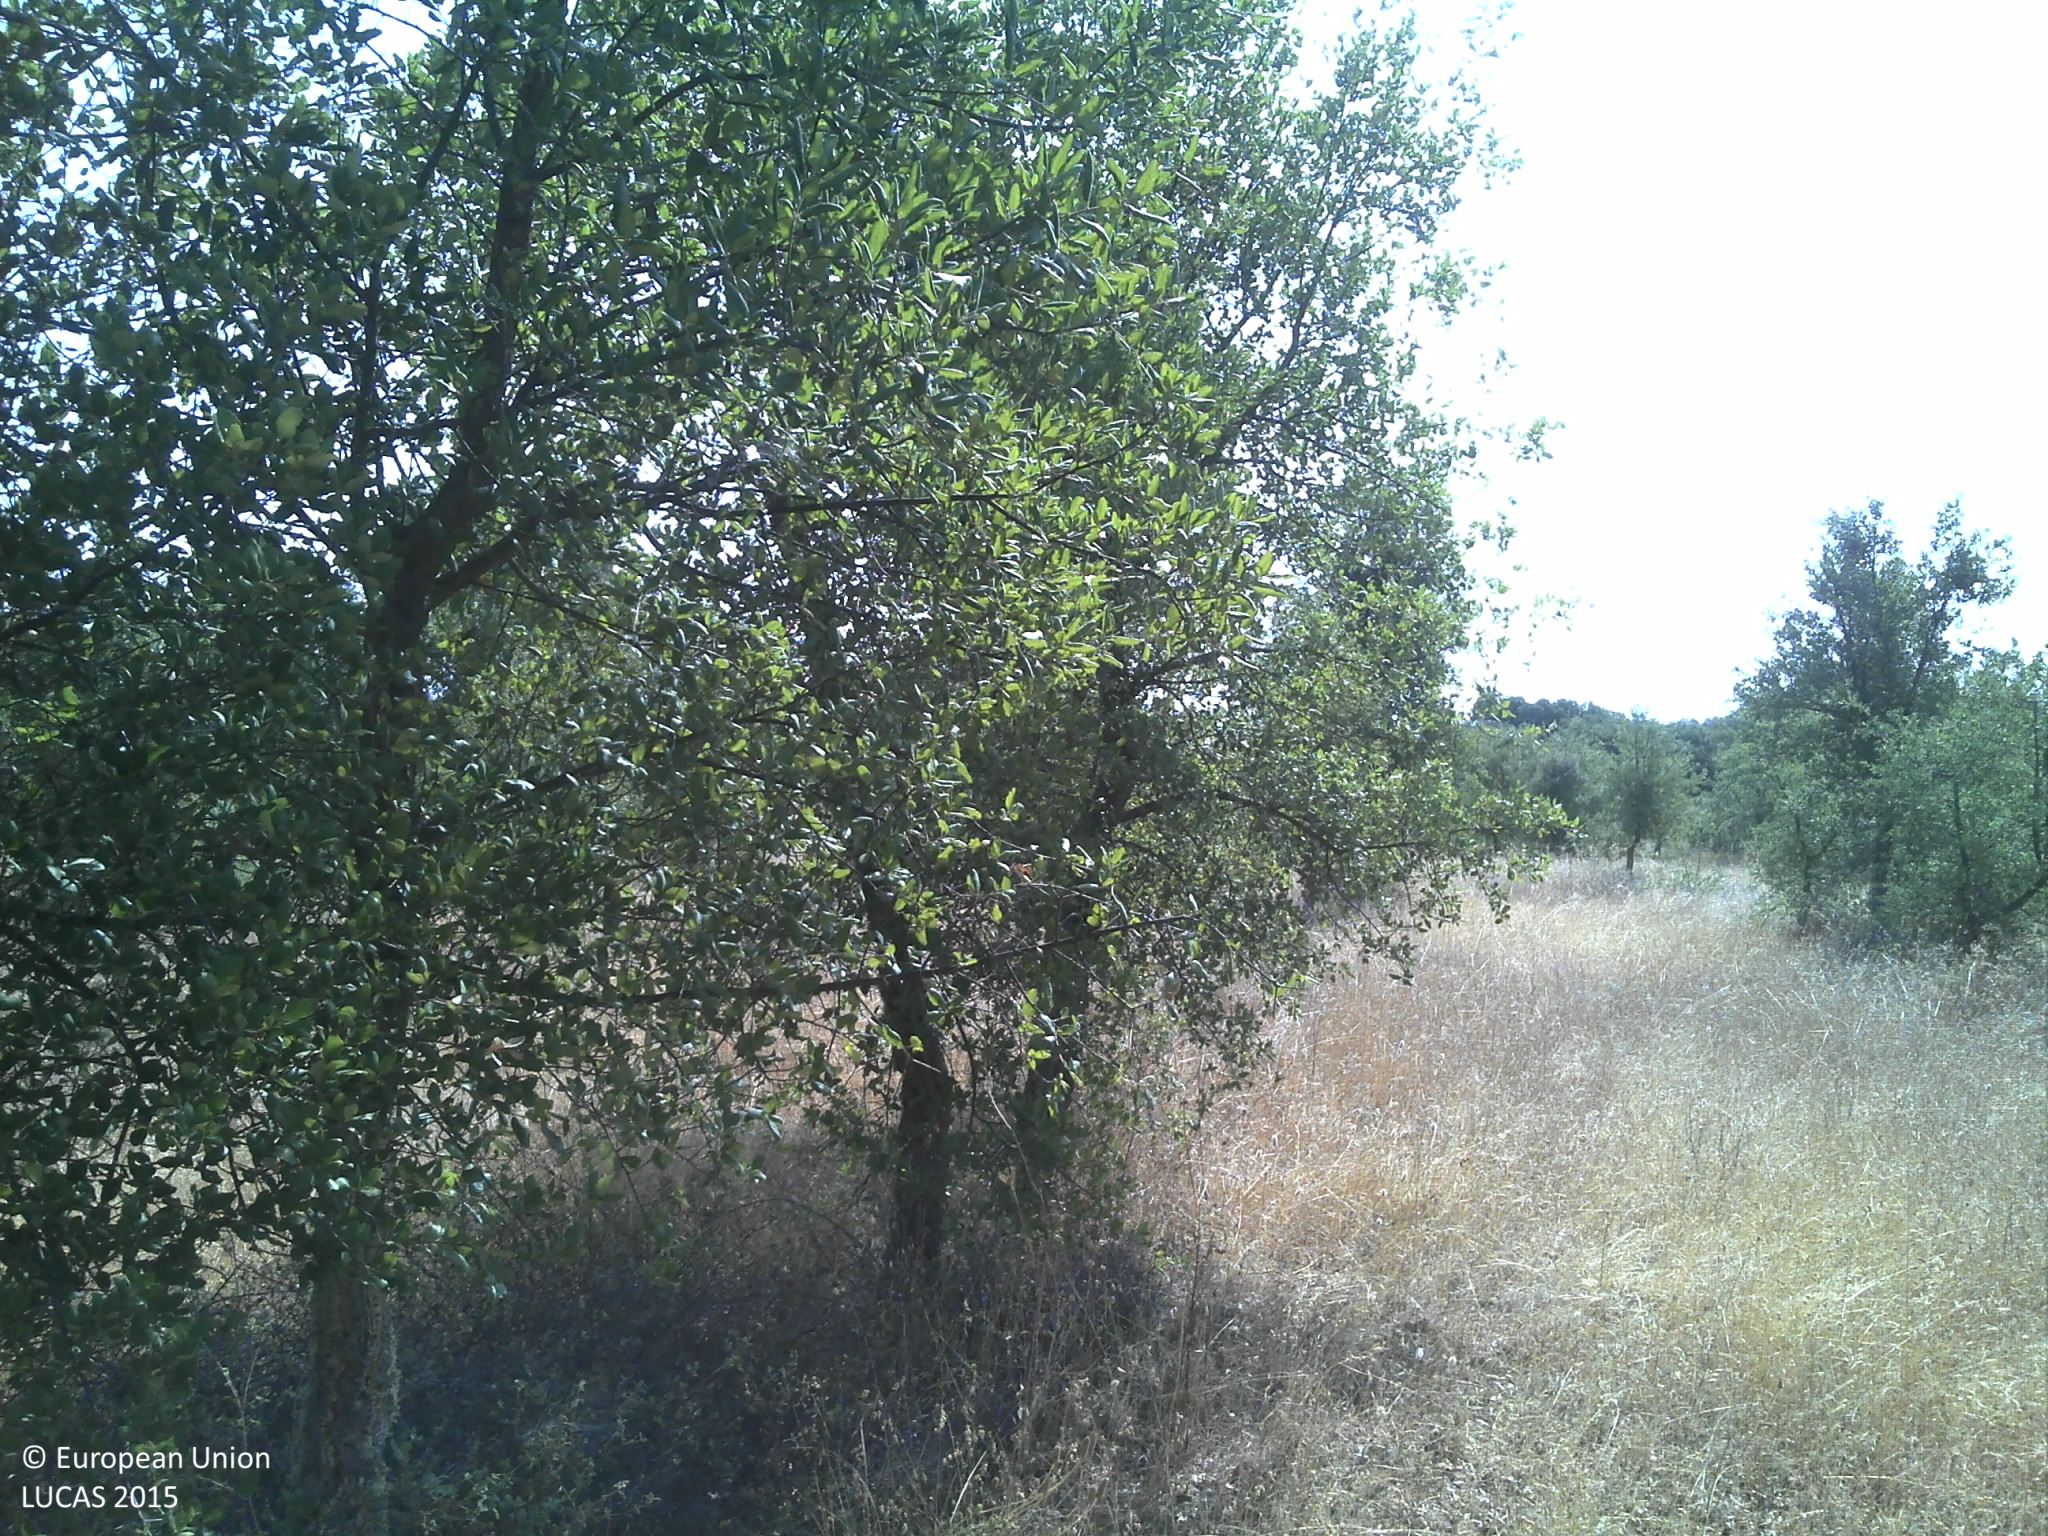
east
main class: Woodland
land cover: Broadleaved woodland
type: broadleaved evergreen forest
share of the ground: 10 - 25 %
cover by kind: herbaceous plants 50 %, unconsolidated bare surface 35 %, broadleaved forest trees 15 %
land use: Forestry
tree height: < 5 m
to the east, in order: Broadleaved woodland; Grassland without tree/shrub cover; Broadleaved woodland; Grassland without tree/shrub cover; Broadleaved woodland; Other bare soil; Broadleaved woodland; Other bare soil; Broadleaved woodland
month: August
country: PT
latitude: 39.2830
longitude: -7.5376
